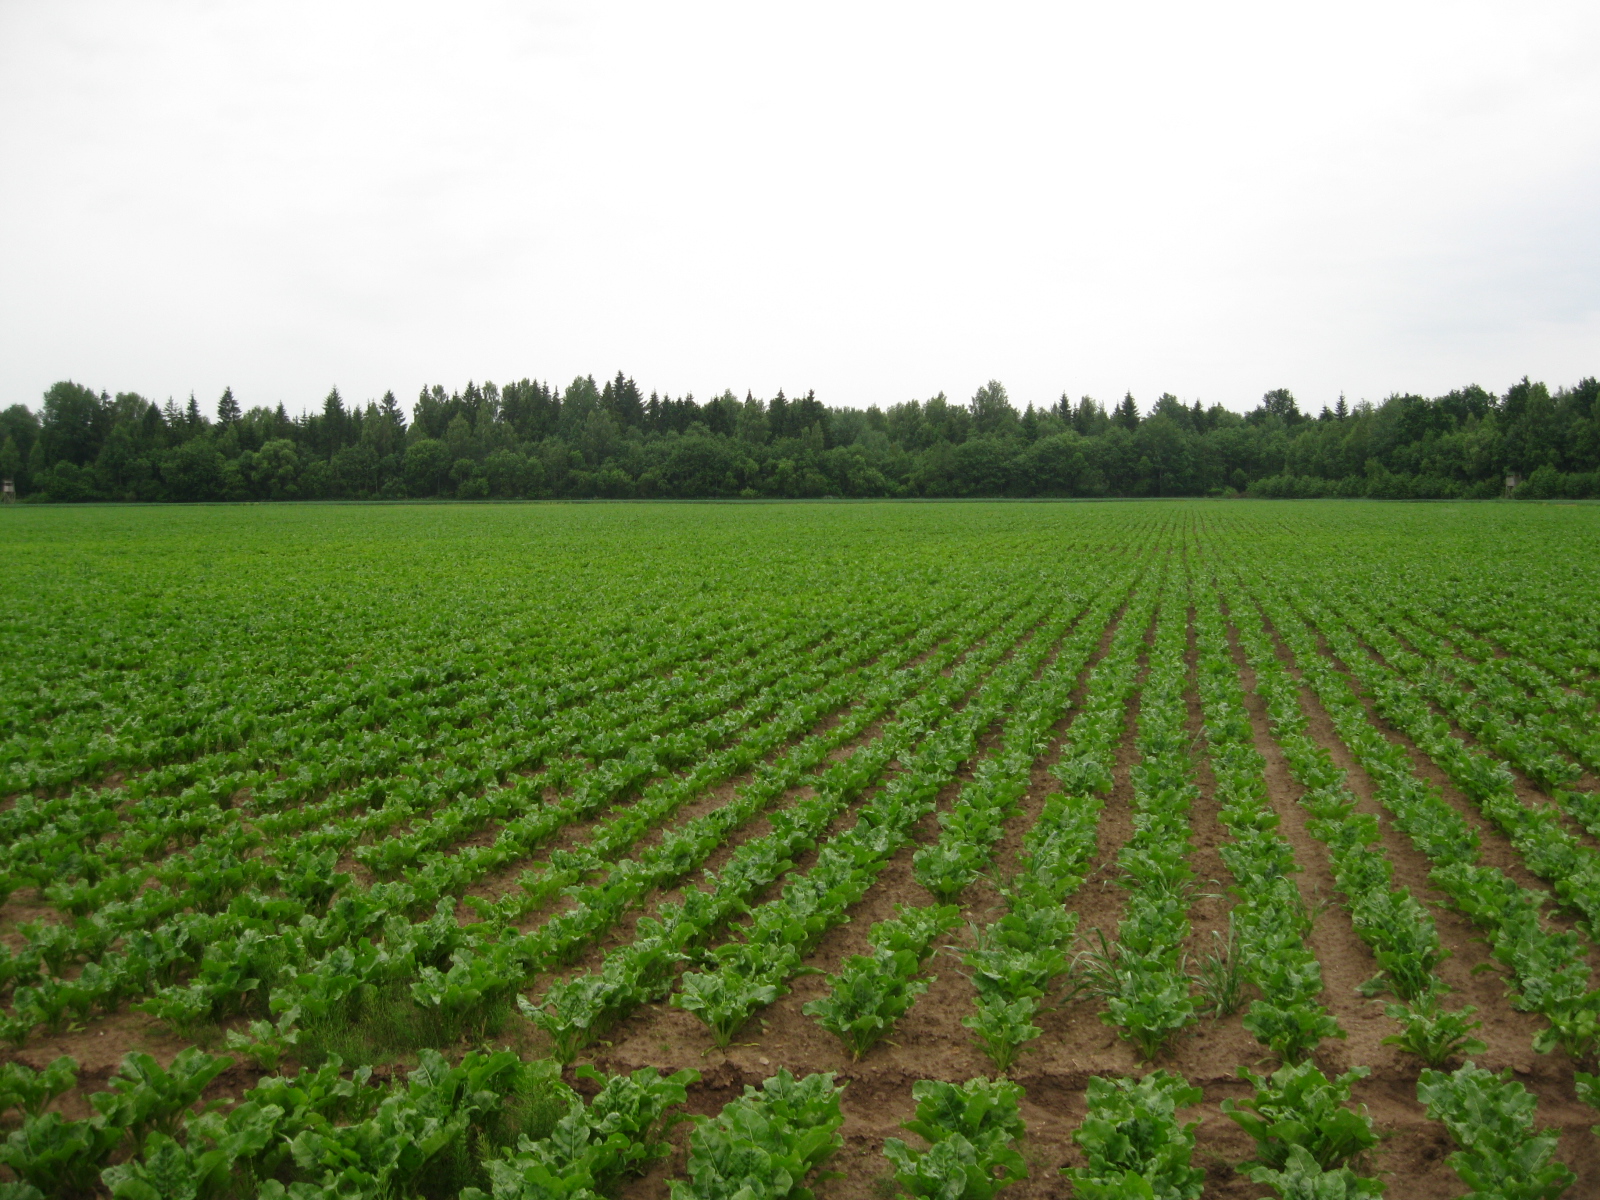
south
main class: Cropland
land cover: Sugar beet
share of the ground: 50 - 75 %
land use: Agriculture (excluding fallow land and kitchen gardens)
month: June
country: LT
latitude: 55.1612
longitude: 23.9809
